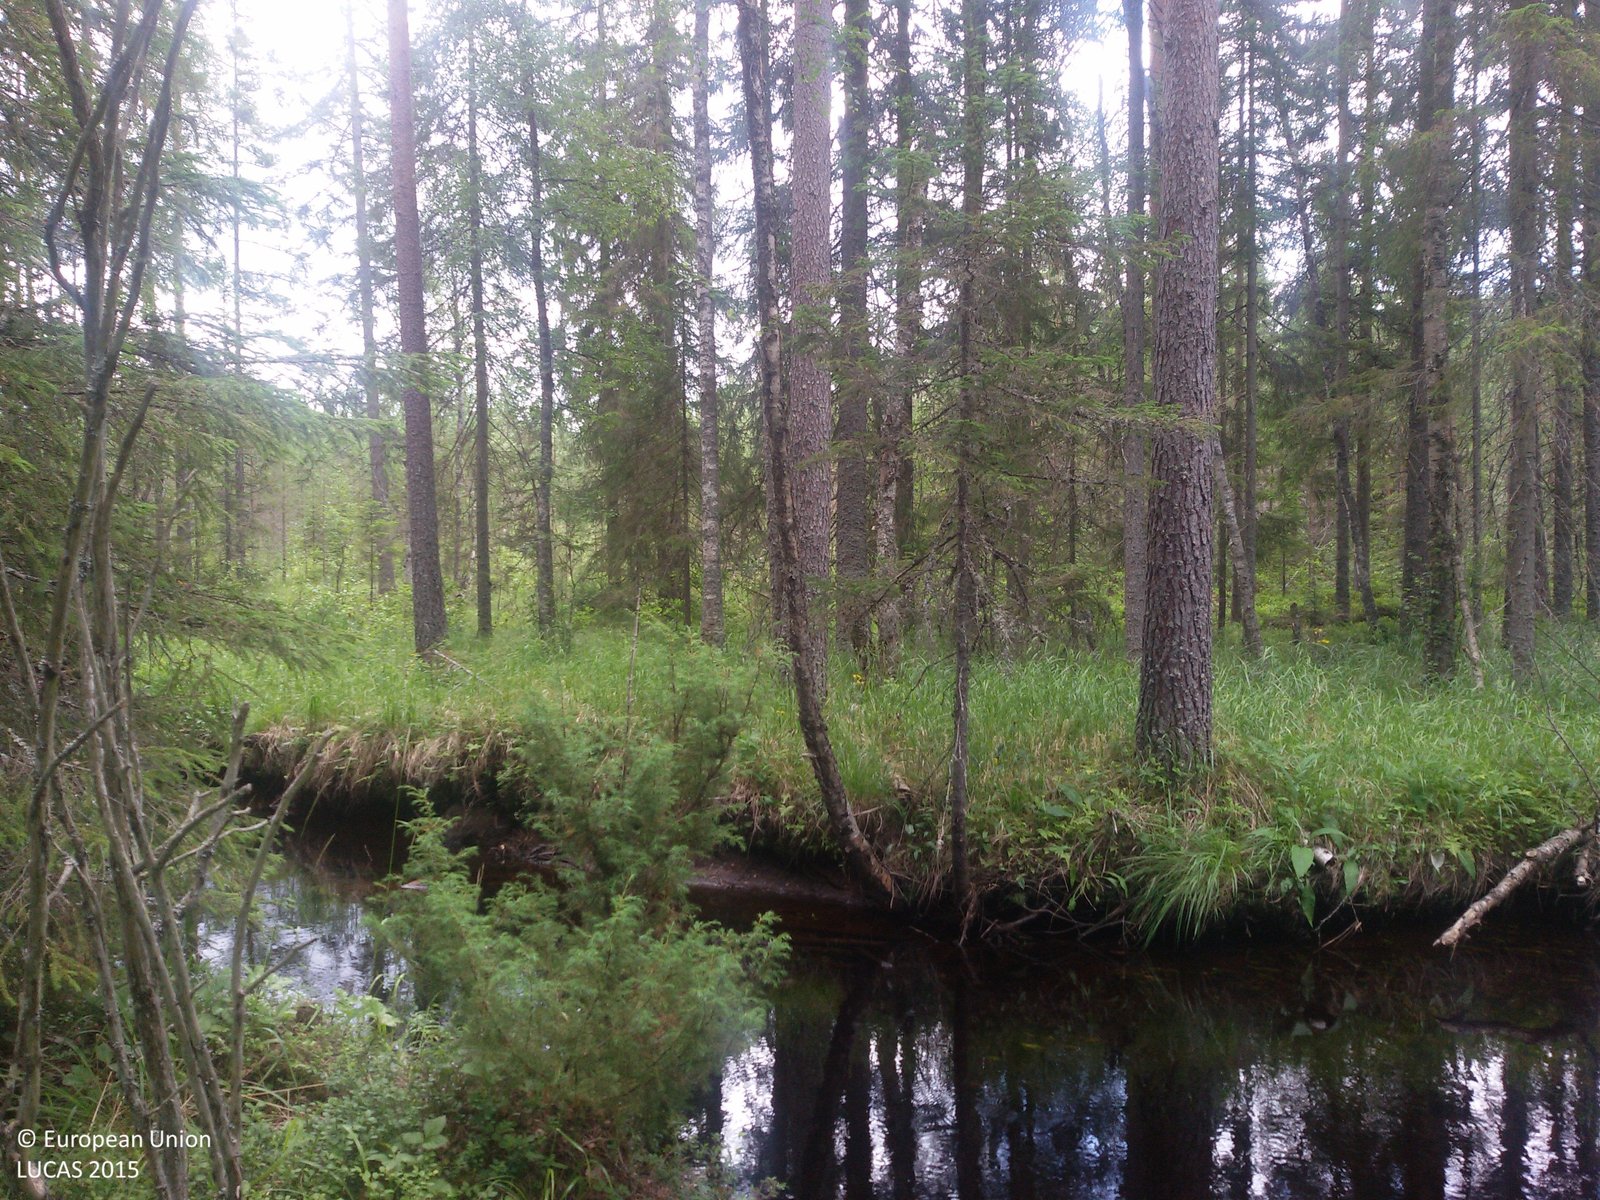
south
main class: Woodland
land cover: Spruce dominated coniferous woodland
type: boreal forest
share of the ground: 50 - 75 %
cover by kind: coniferous forest trees 75 %, shrubs 25 %
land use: Forestry
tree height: > 5 m
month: July
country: SE
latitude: 60.4636
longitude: 15.2070
